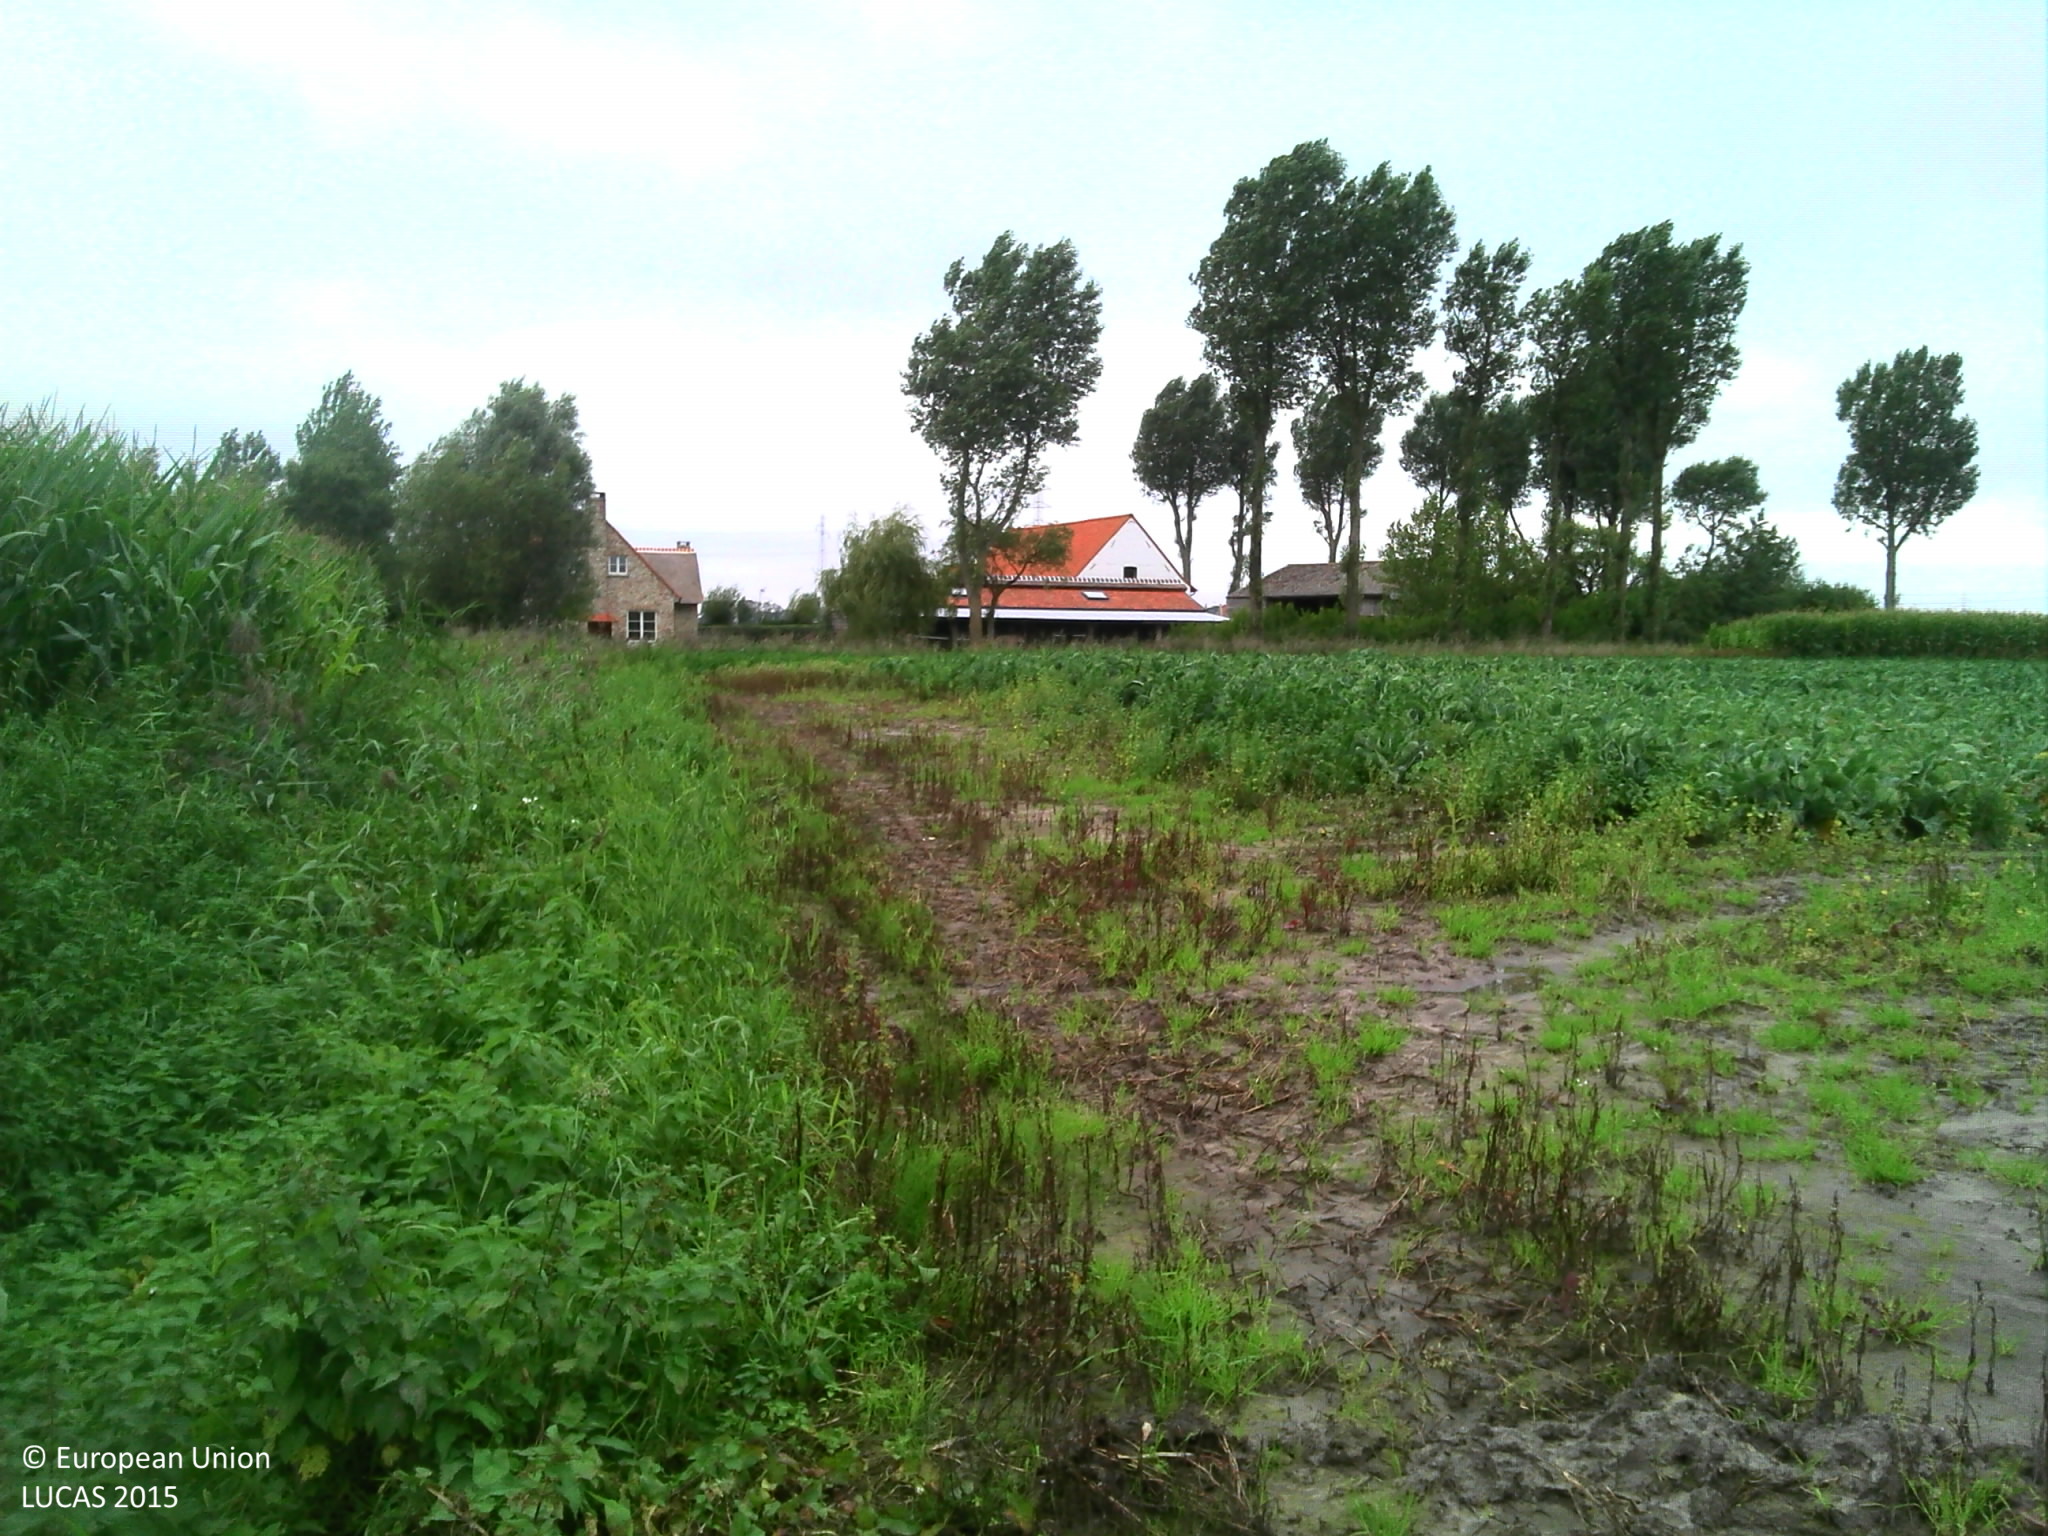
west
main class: Cropland
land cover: Maize
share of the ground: > 75 %
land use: Agriculture (excluding fallow land and kitchen gardens)
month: September
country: BE
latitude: 51.0620
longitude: 2.8691
